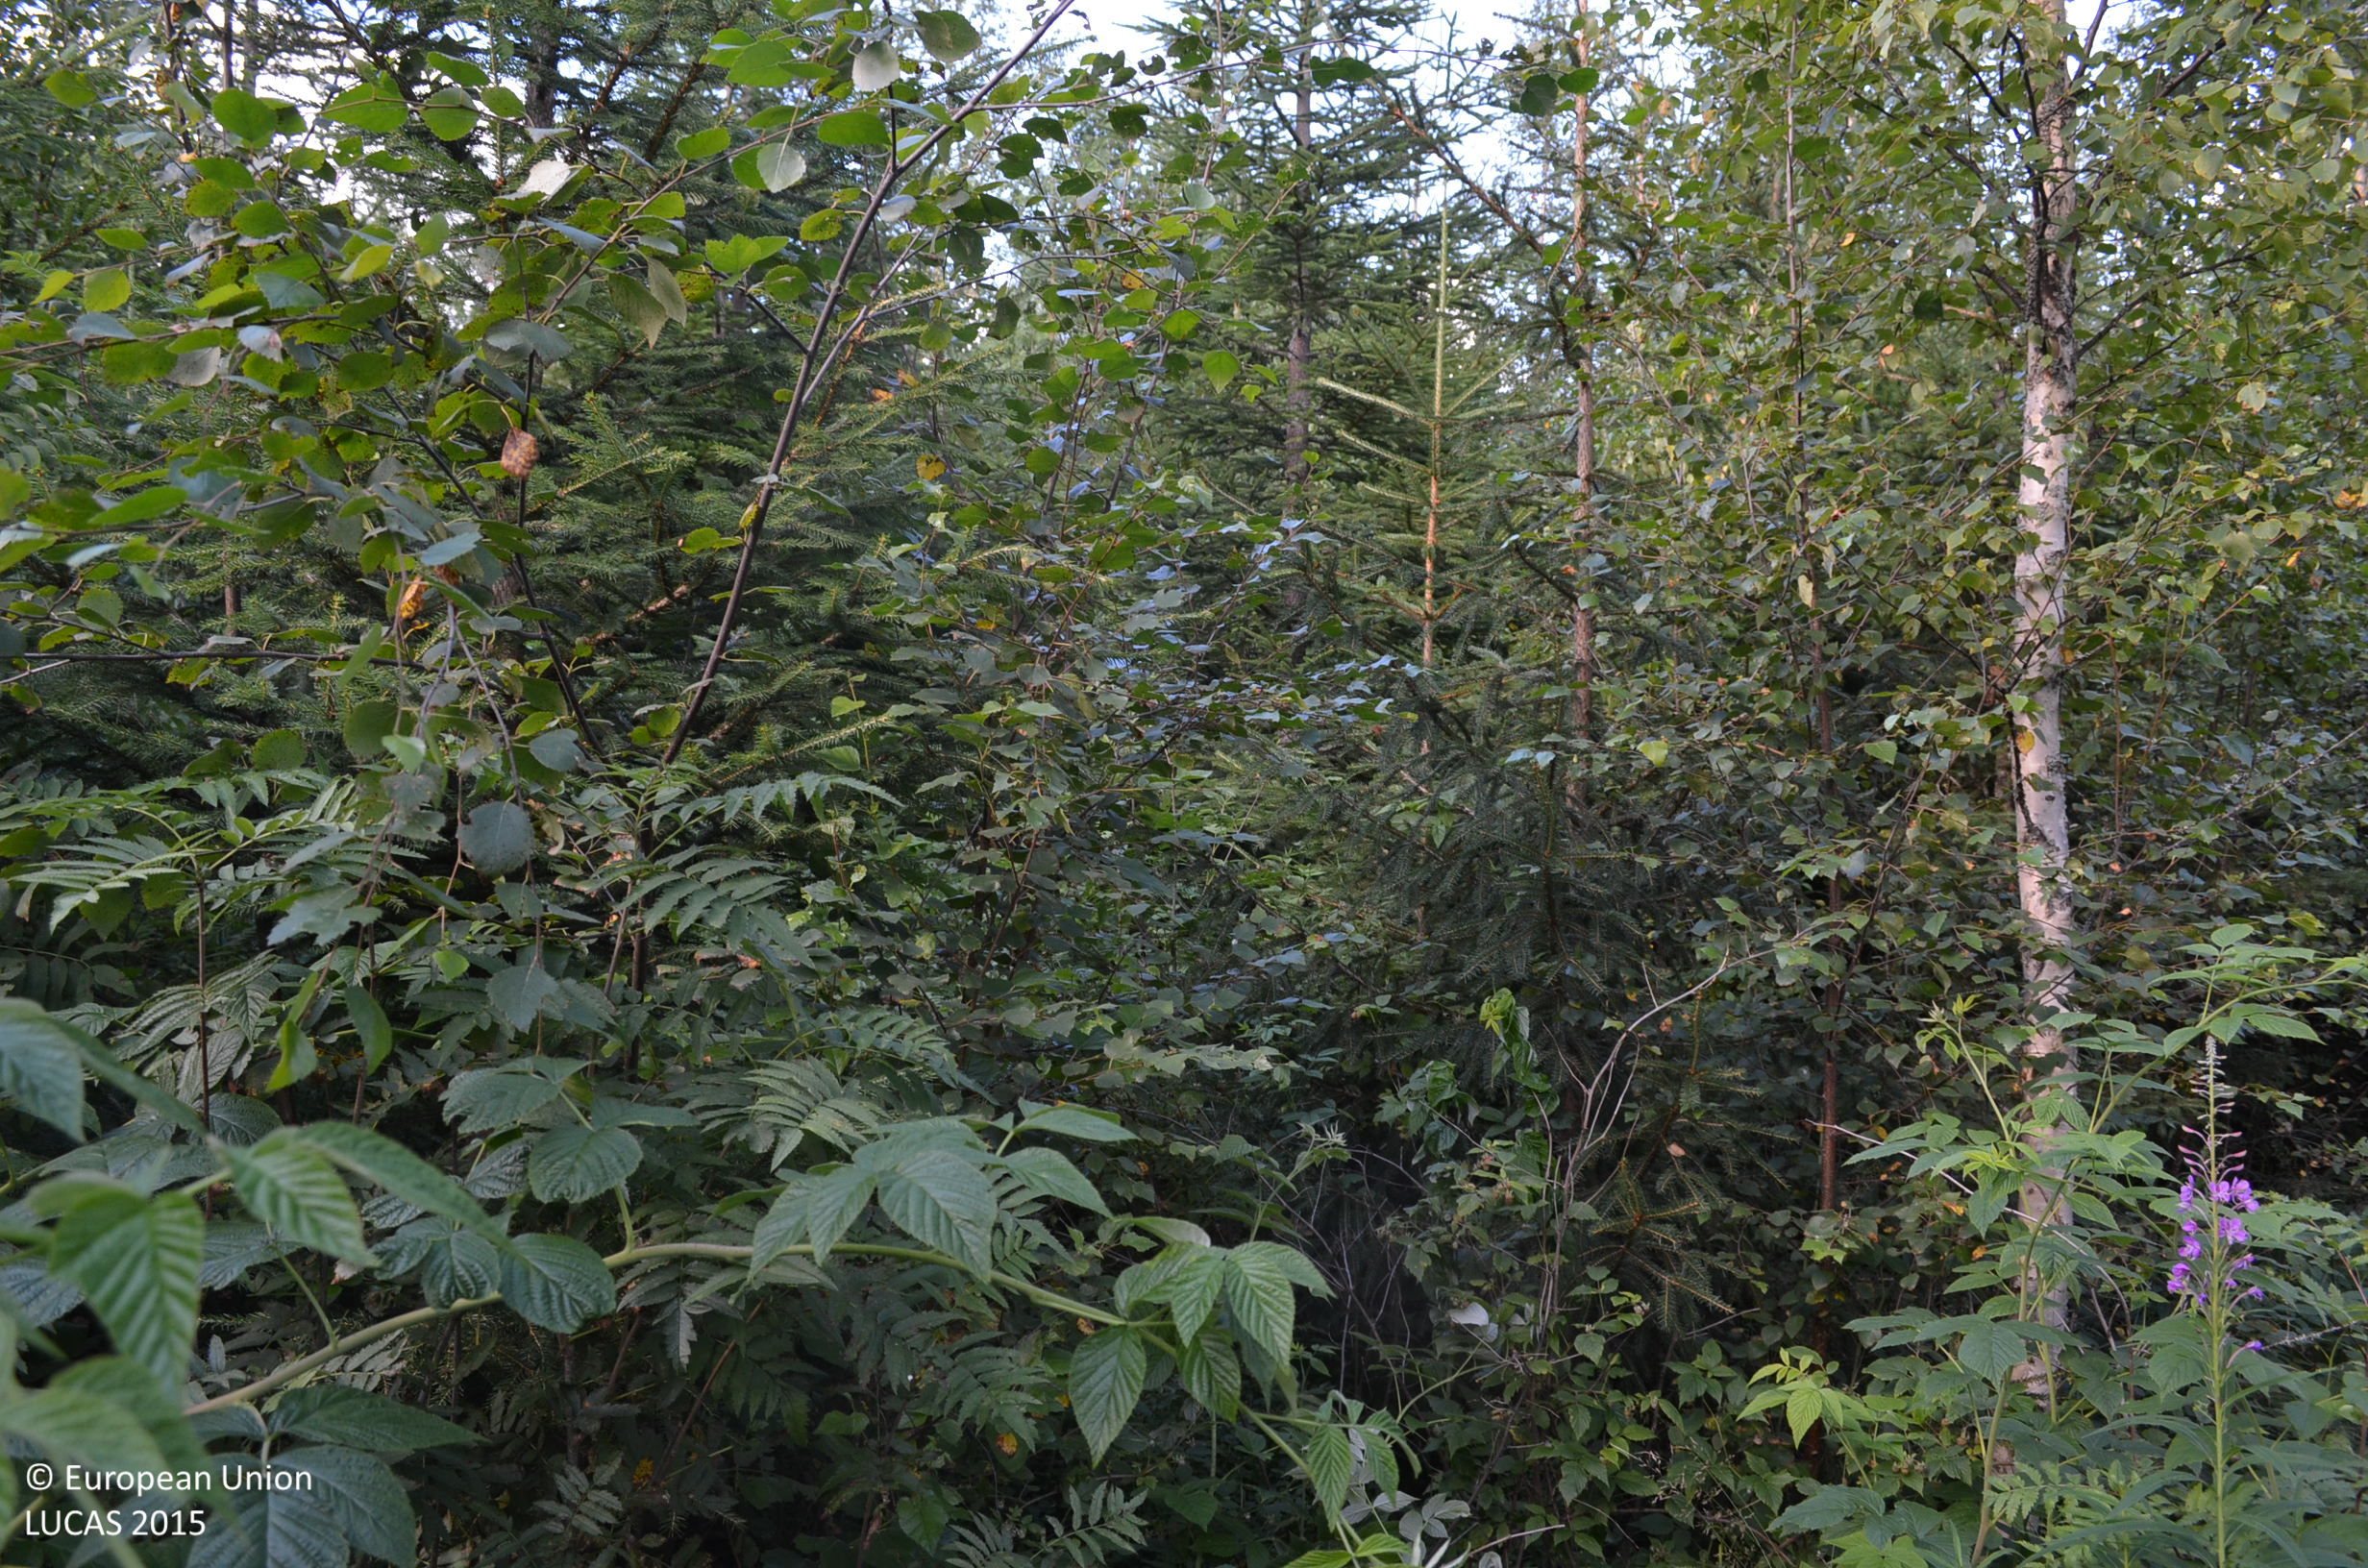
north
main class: Woodland
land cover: Spruce dominated mixed woodland
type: boreal forest
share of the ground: > 75 %
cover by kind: broadleaved forest trees 40 %, coniferous forest trees 35 %, shrubs 20 %, herbaceous plants 5 %
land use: Forestry
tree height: < 5 m
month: August
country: FI
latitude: 61.5945
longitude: 23.1312
